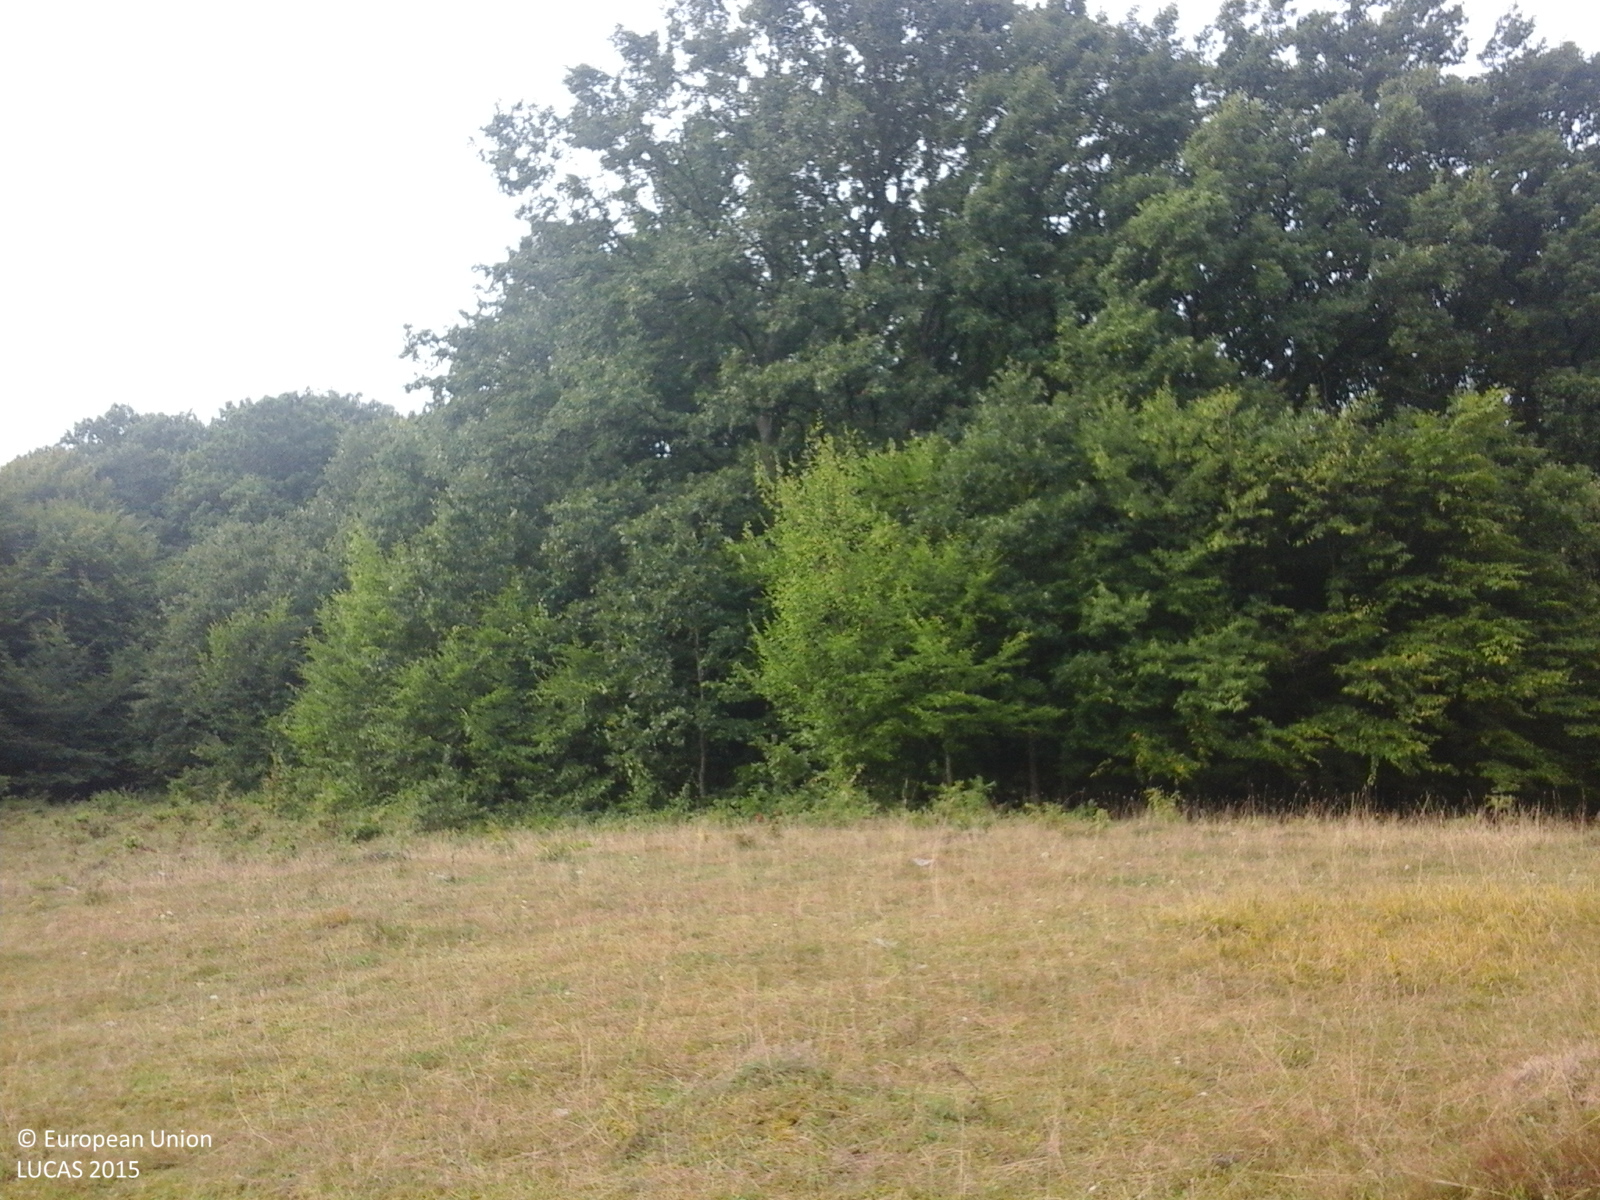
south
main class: Grassland
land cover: Grassland without tree/shrub cover
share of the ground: > 75 %
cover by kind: herbaceous plants 100 %
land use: Agriculture (excluding fallow land and kitchen gardens)
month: September
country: RO
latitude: 46.9153
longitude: 23.0485
